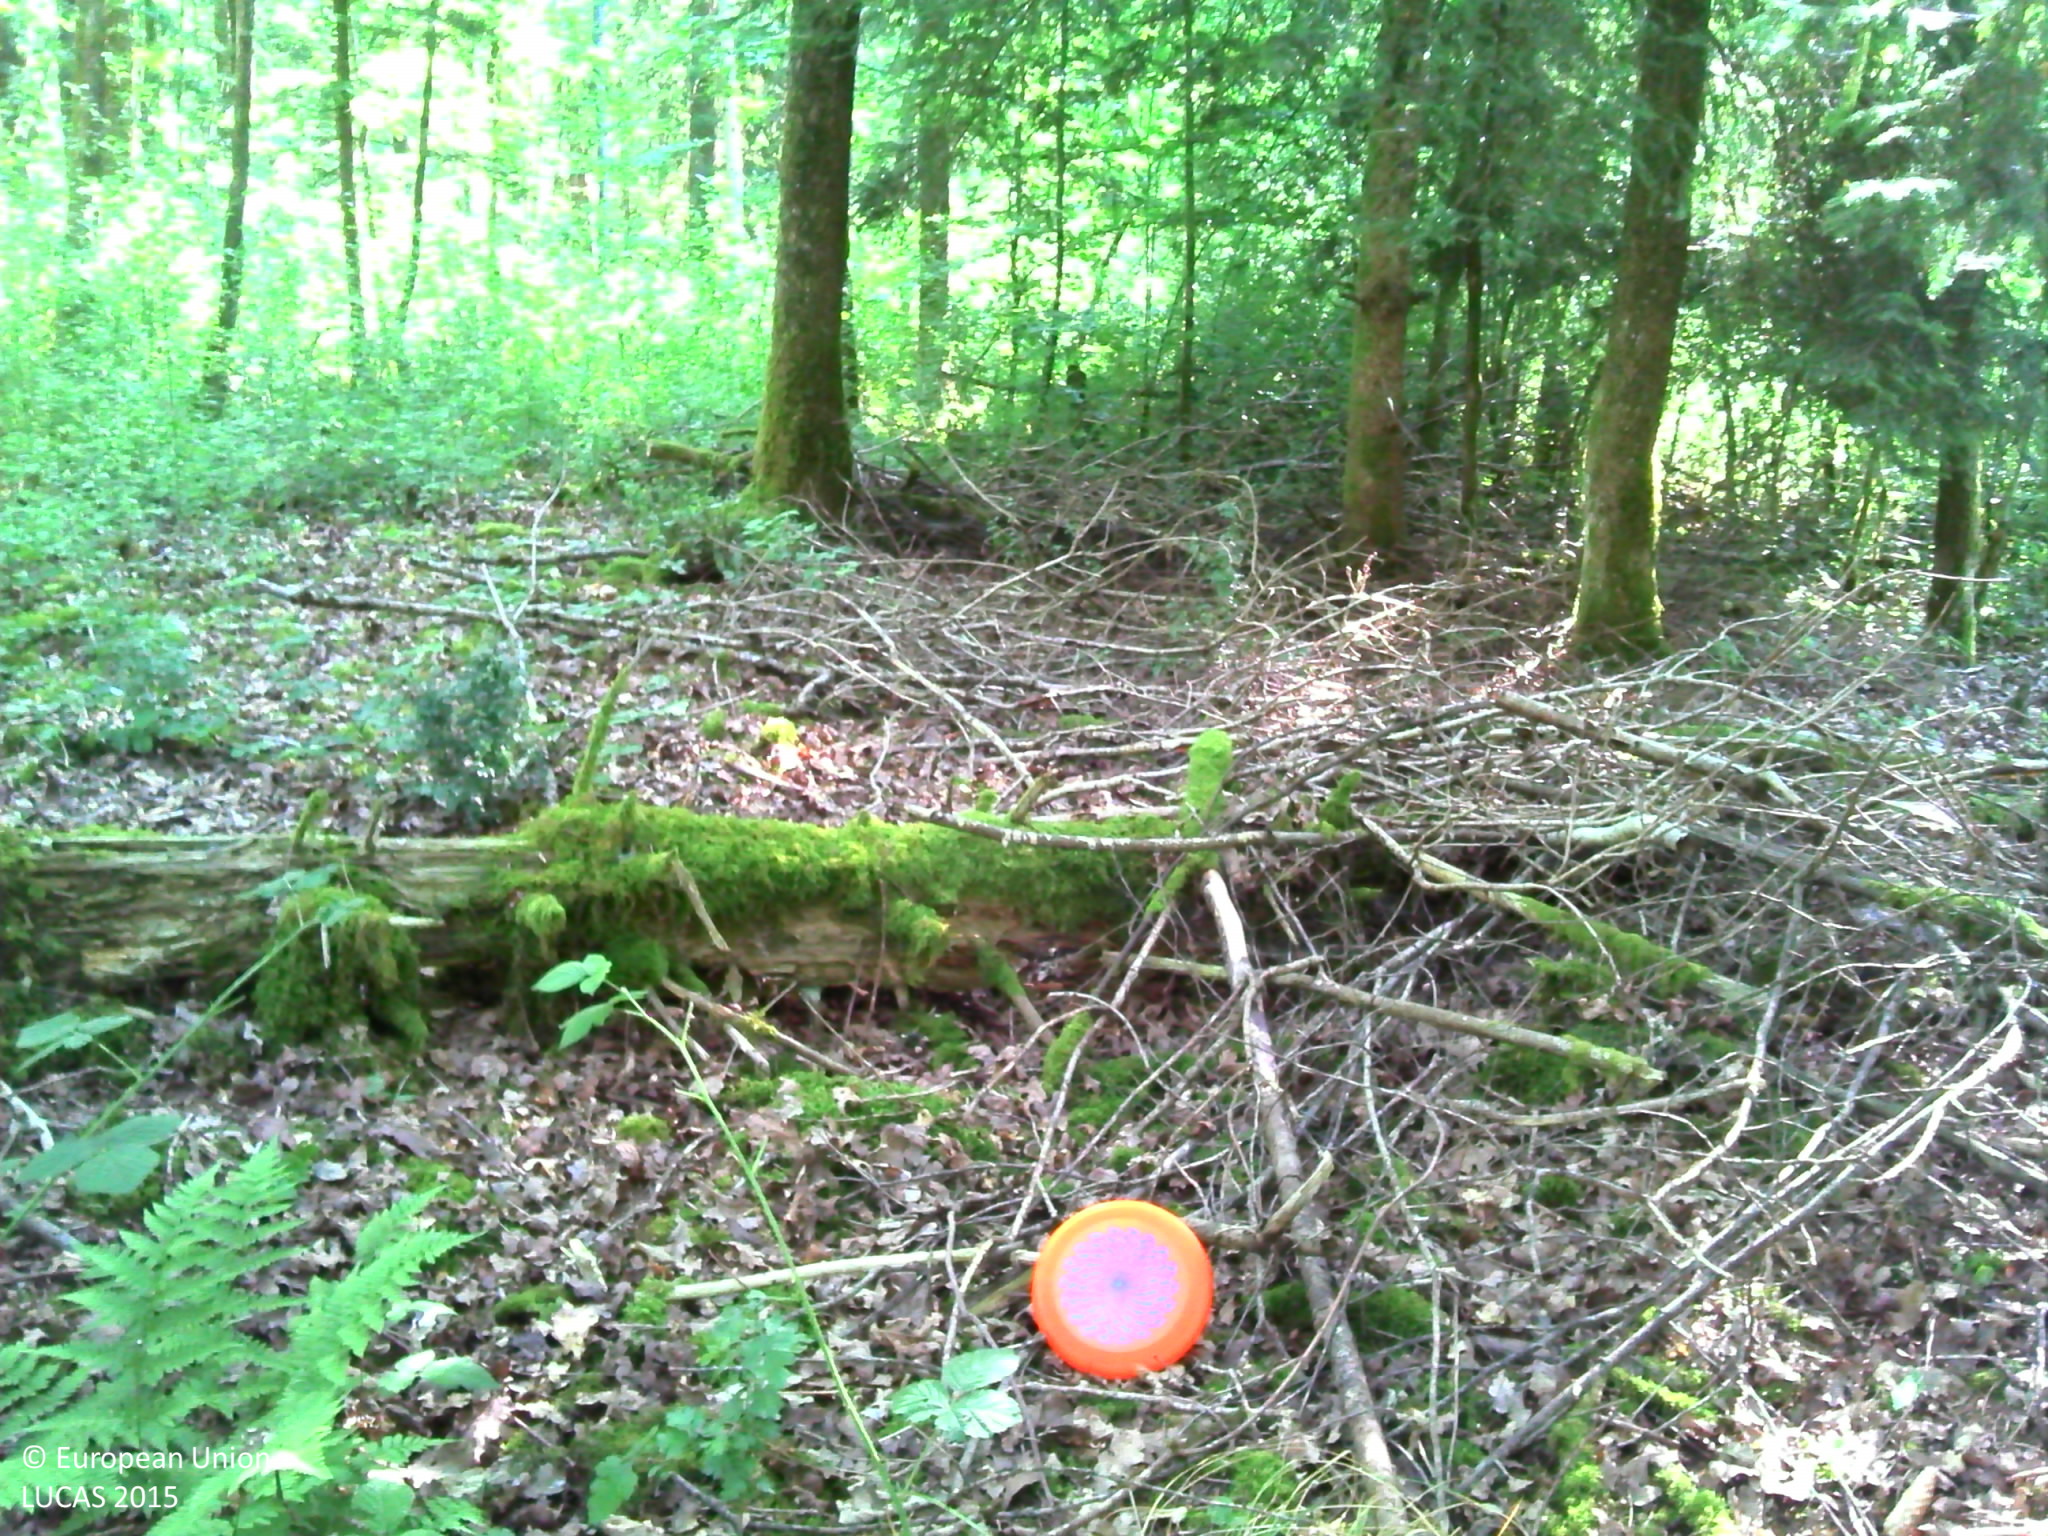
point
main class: Woodland
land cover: Broadleaved woodland
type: acidophilous oak and oak-birch forest
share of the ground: > 75 %
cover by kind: broadleaved forest trees 90 %, coniferous forest trees 10 %
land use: Forestry
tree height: > 5 m
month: July
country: BE
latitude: 49.6831
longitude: 5.5495
